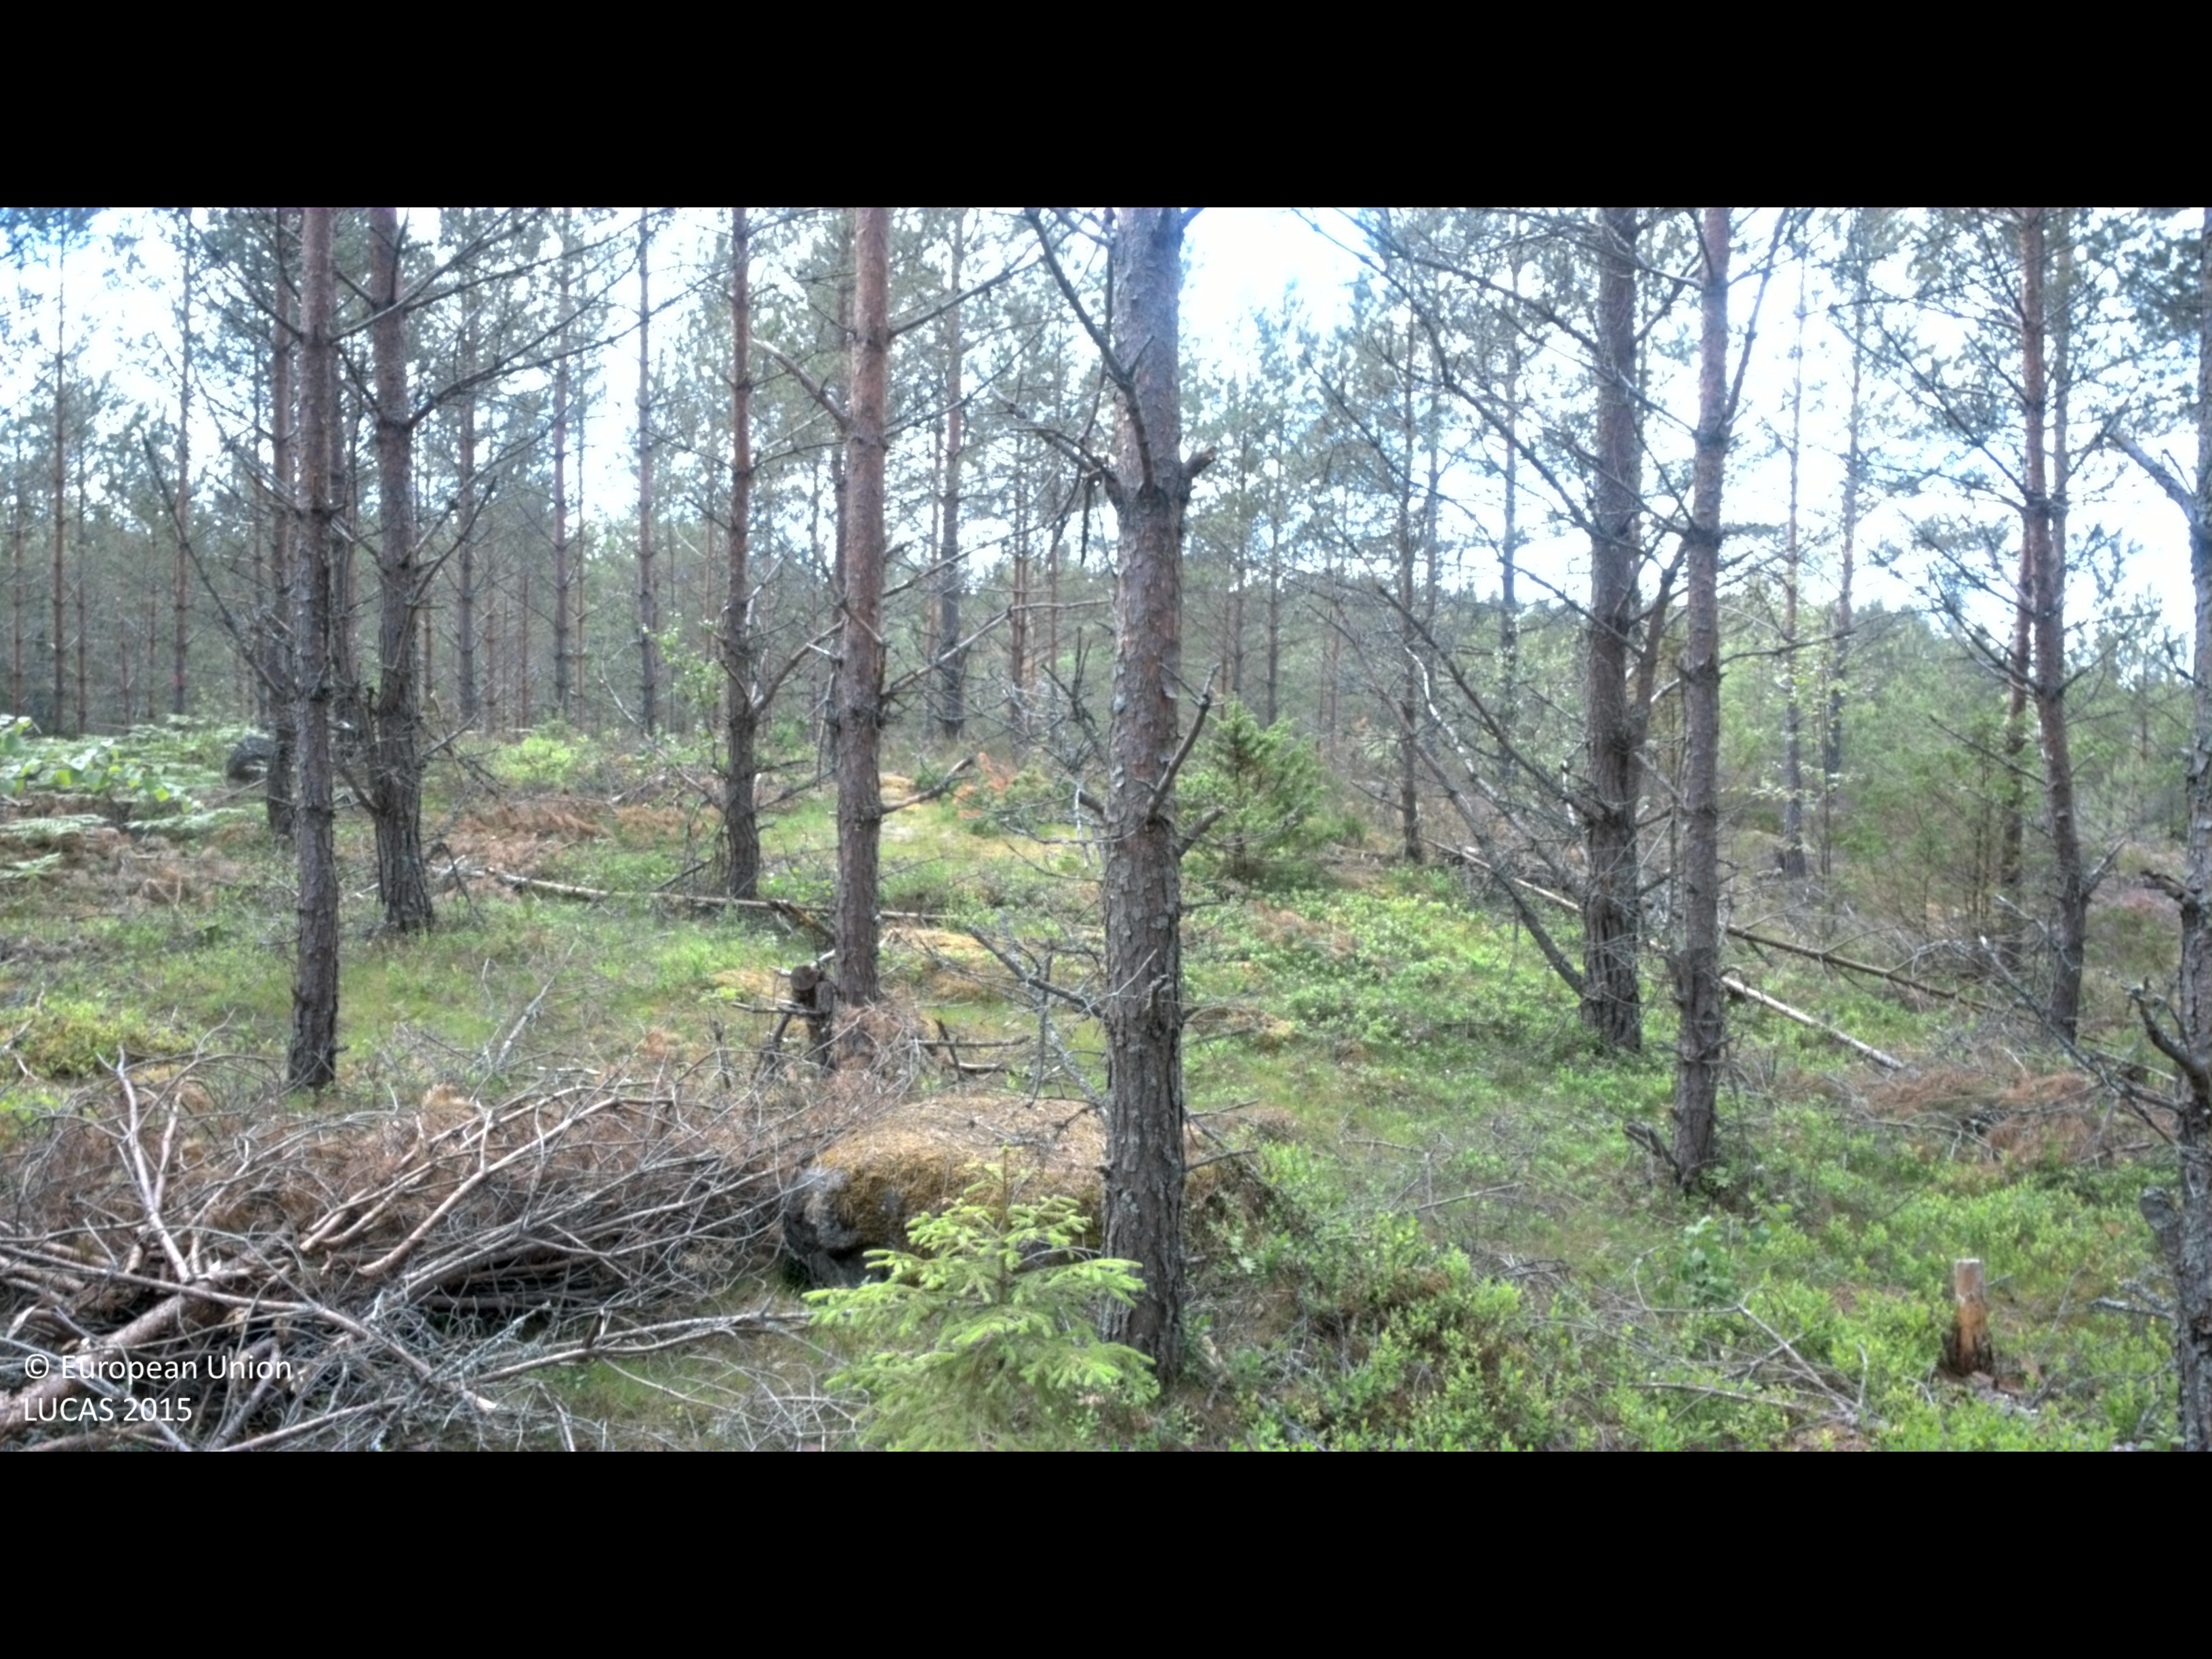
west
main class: Woodland
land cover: Pine dominated coniferous woodland
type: boreal forest
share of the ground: 50 - 75 %
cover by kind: coniferous forest trees 60 %, shrubs 20 %, herbaceous plants 10 %, broadleaved forest trees 5 %, unconsolidated bare surface 5 %
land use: Forestry
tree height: > 5 m
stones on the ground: < 10 %
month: June
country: SE
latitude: 57.7000
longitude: 16.5257
